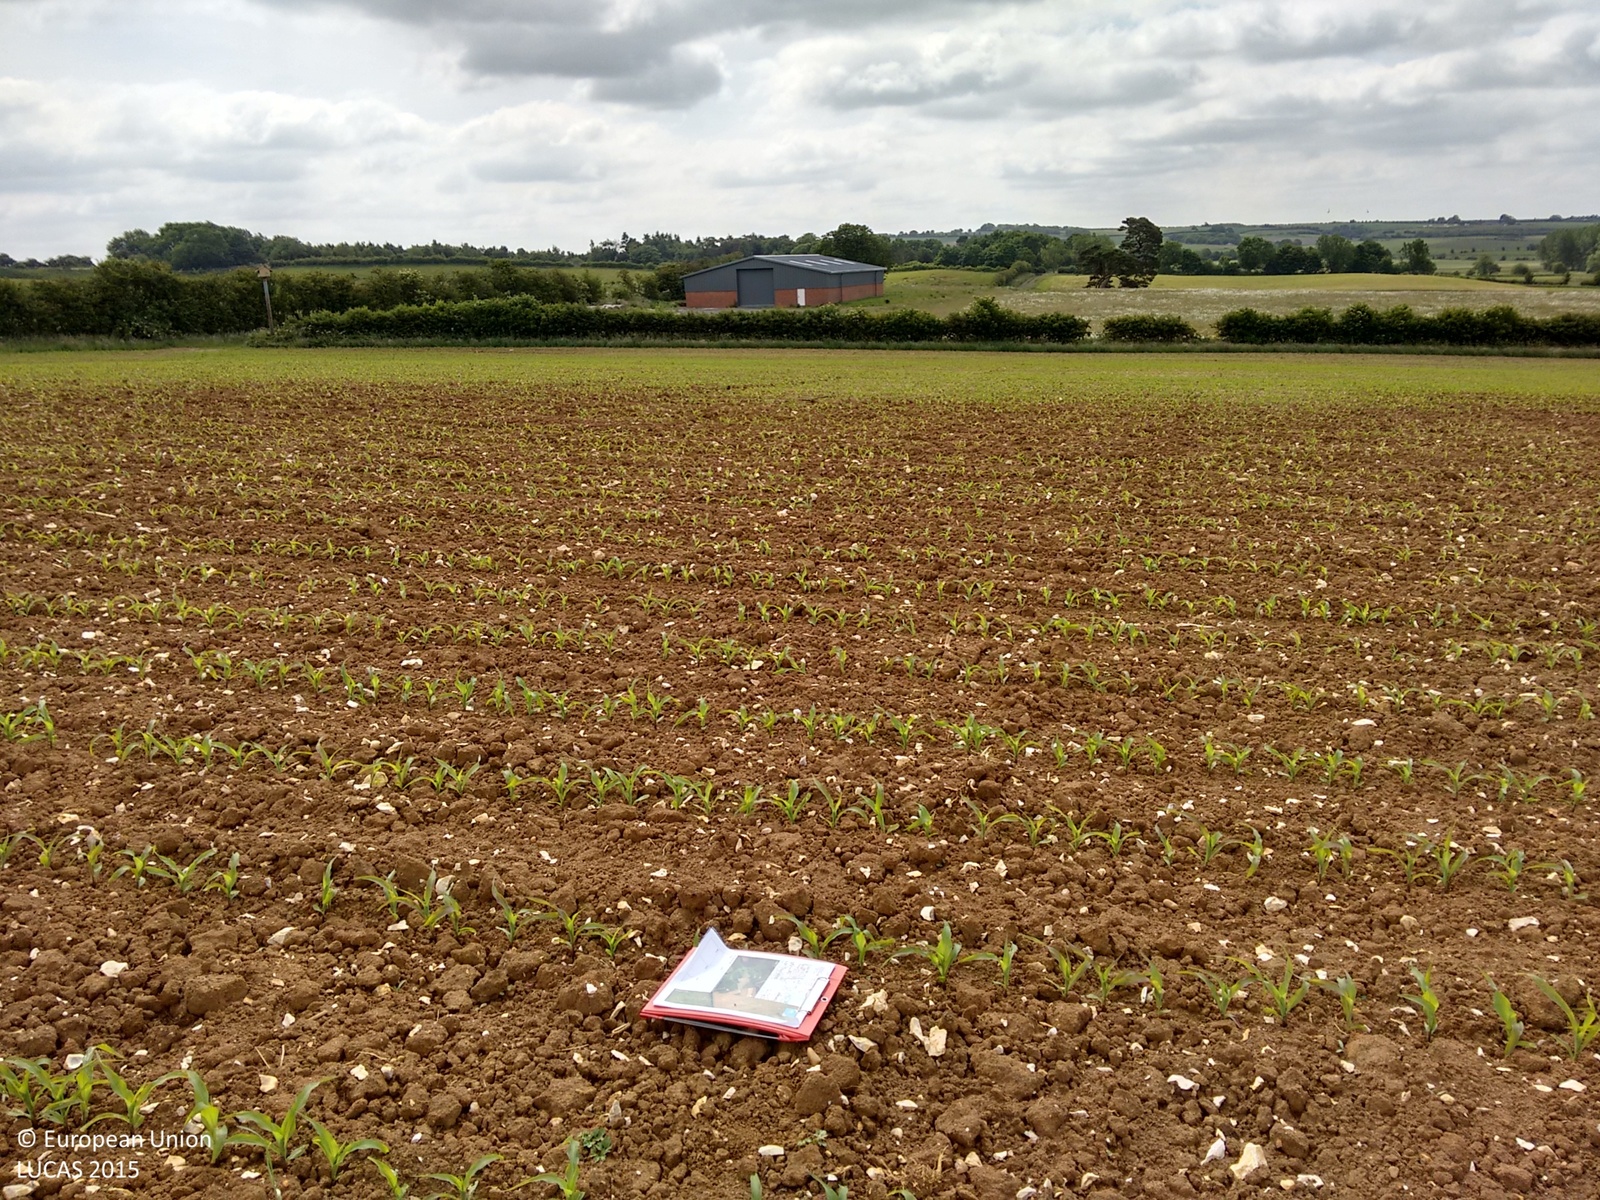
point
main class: Cropland
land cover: Maize
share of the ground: < 10 %
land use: Agriculture (excluding fallow land and kitchen gardens)
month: June
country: GB
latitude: 53.3021
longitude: -0.1321
